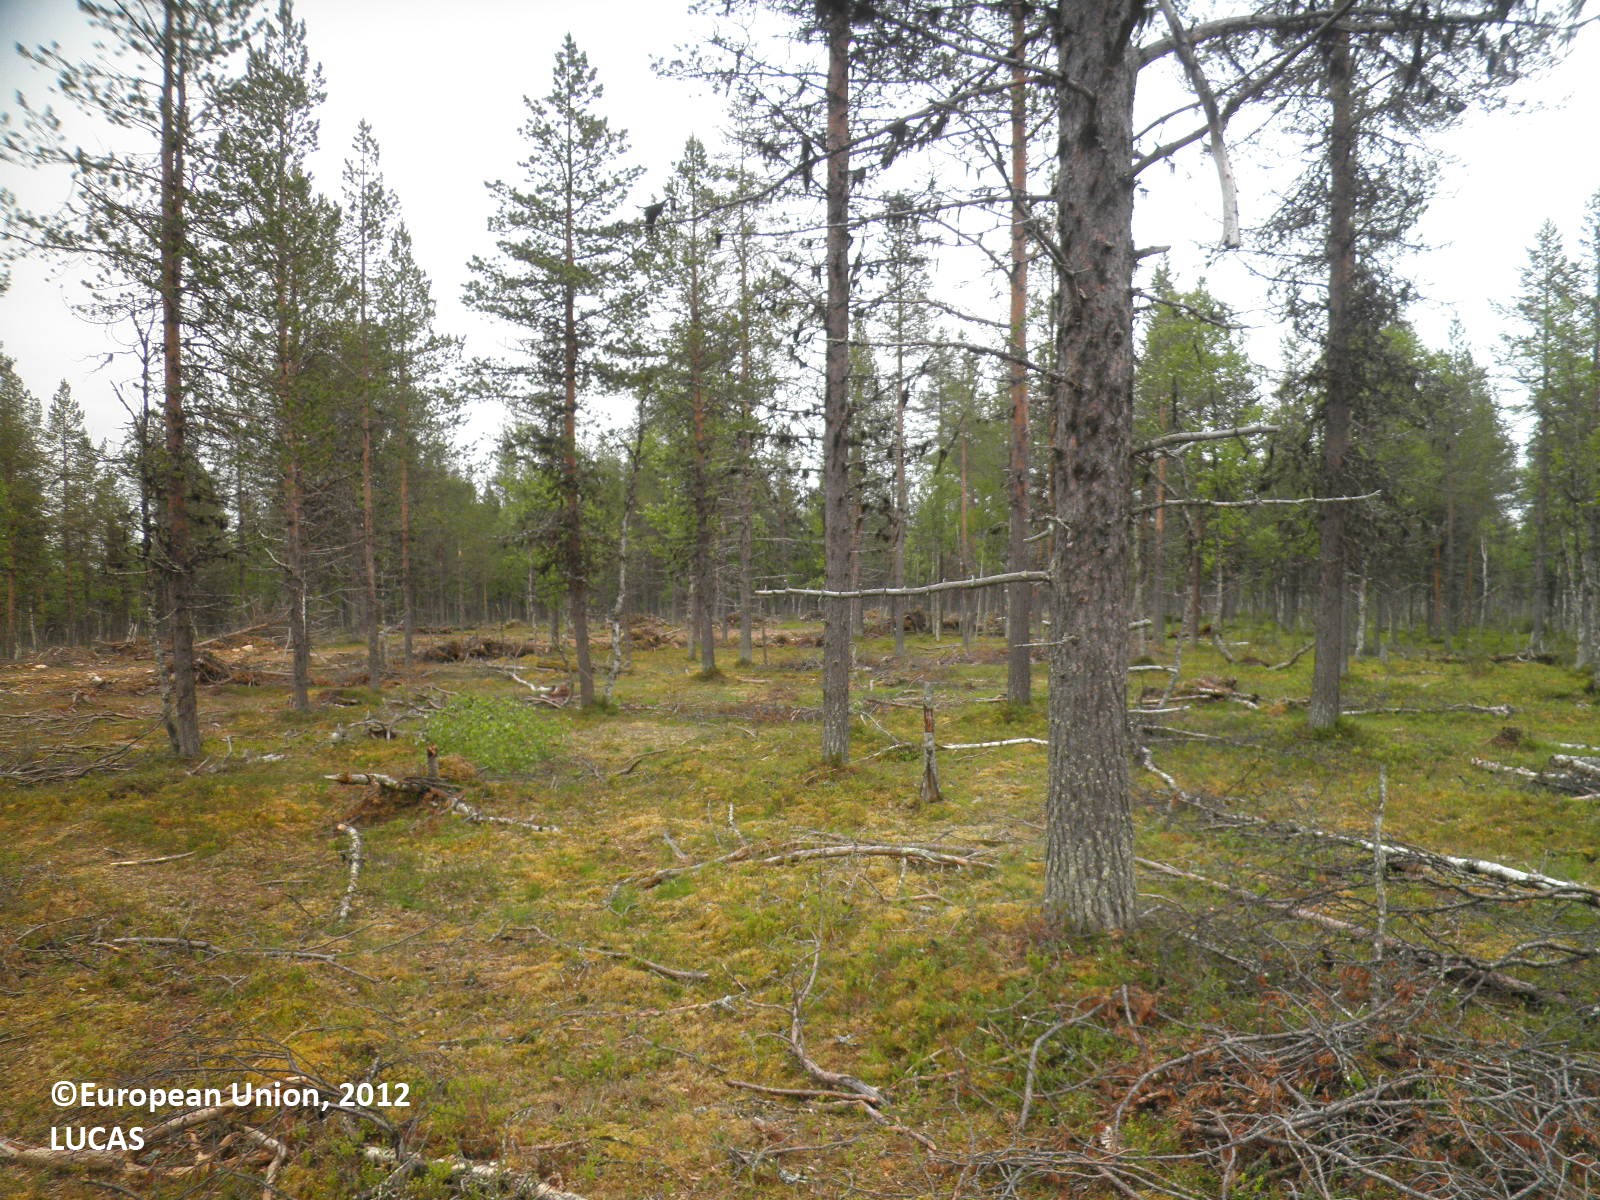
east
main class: Woodland
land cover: Pine dominated coniferous woodland
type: boreal forest
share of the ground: 25 - 50 %
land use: Forestry
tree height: > 5 m
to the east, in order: Pine dominated coniferous woodland; Tracks; Pine dominated mixed woodland; Pine dominated coniferous woodland
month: July
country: FI
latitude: 68.2420
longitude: 25.5332
